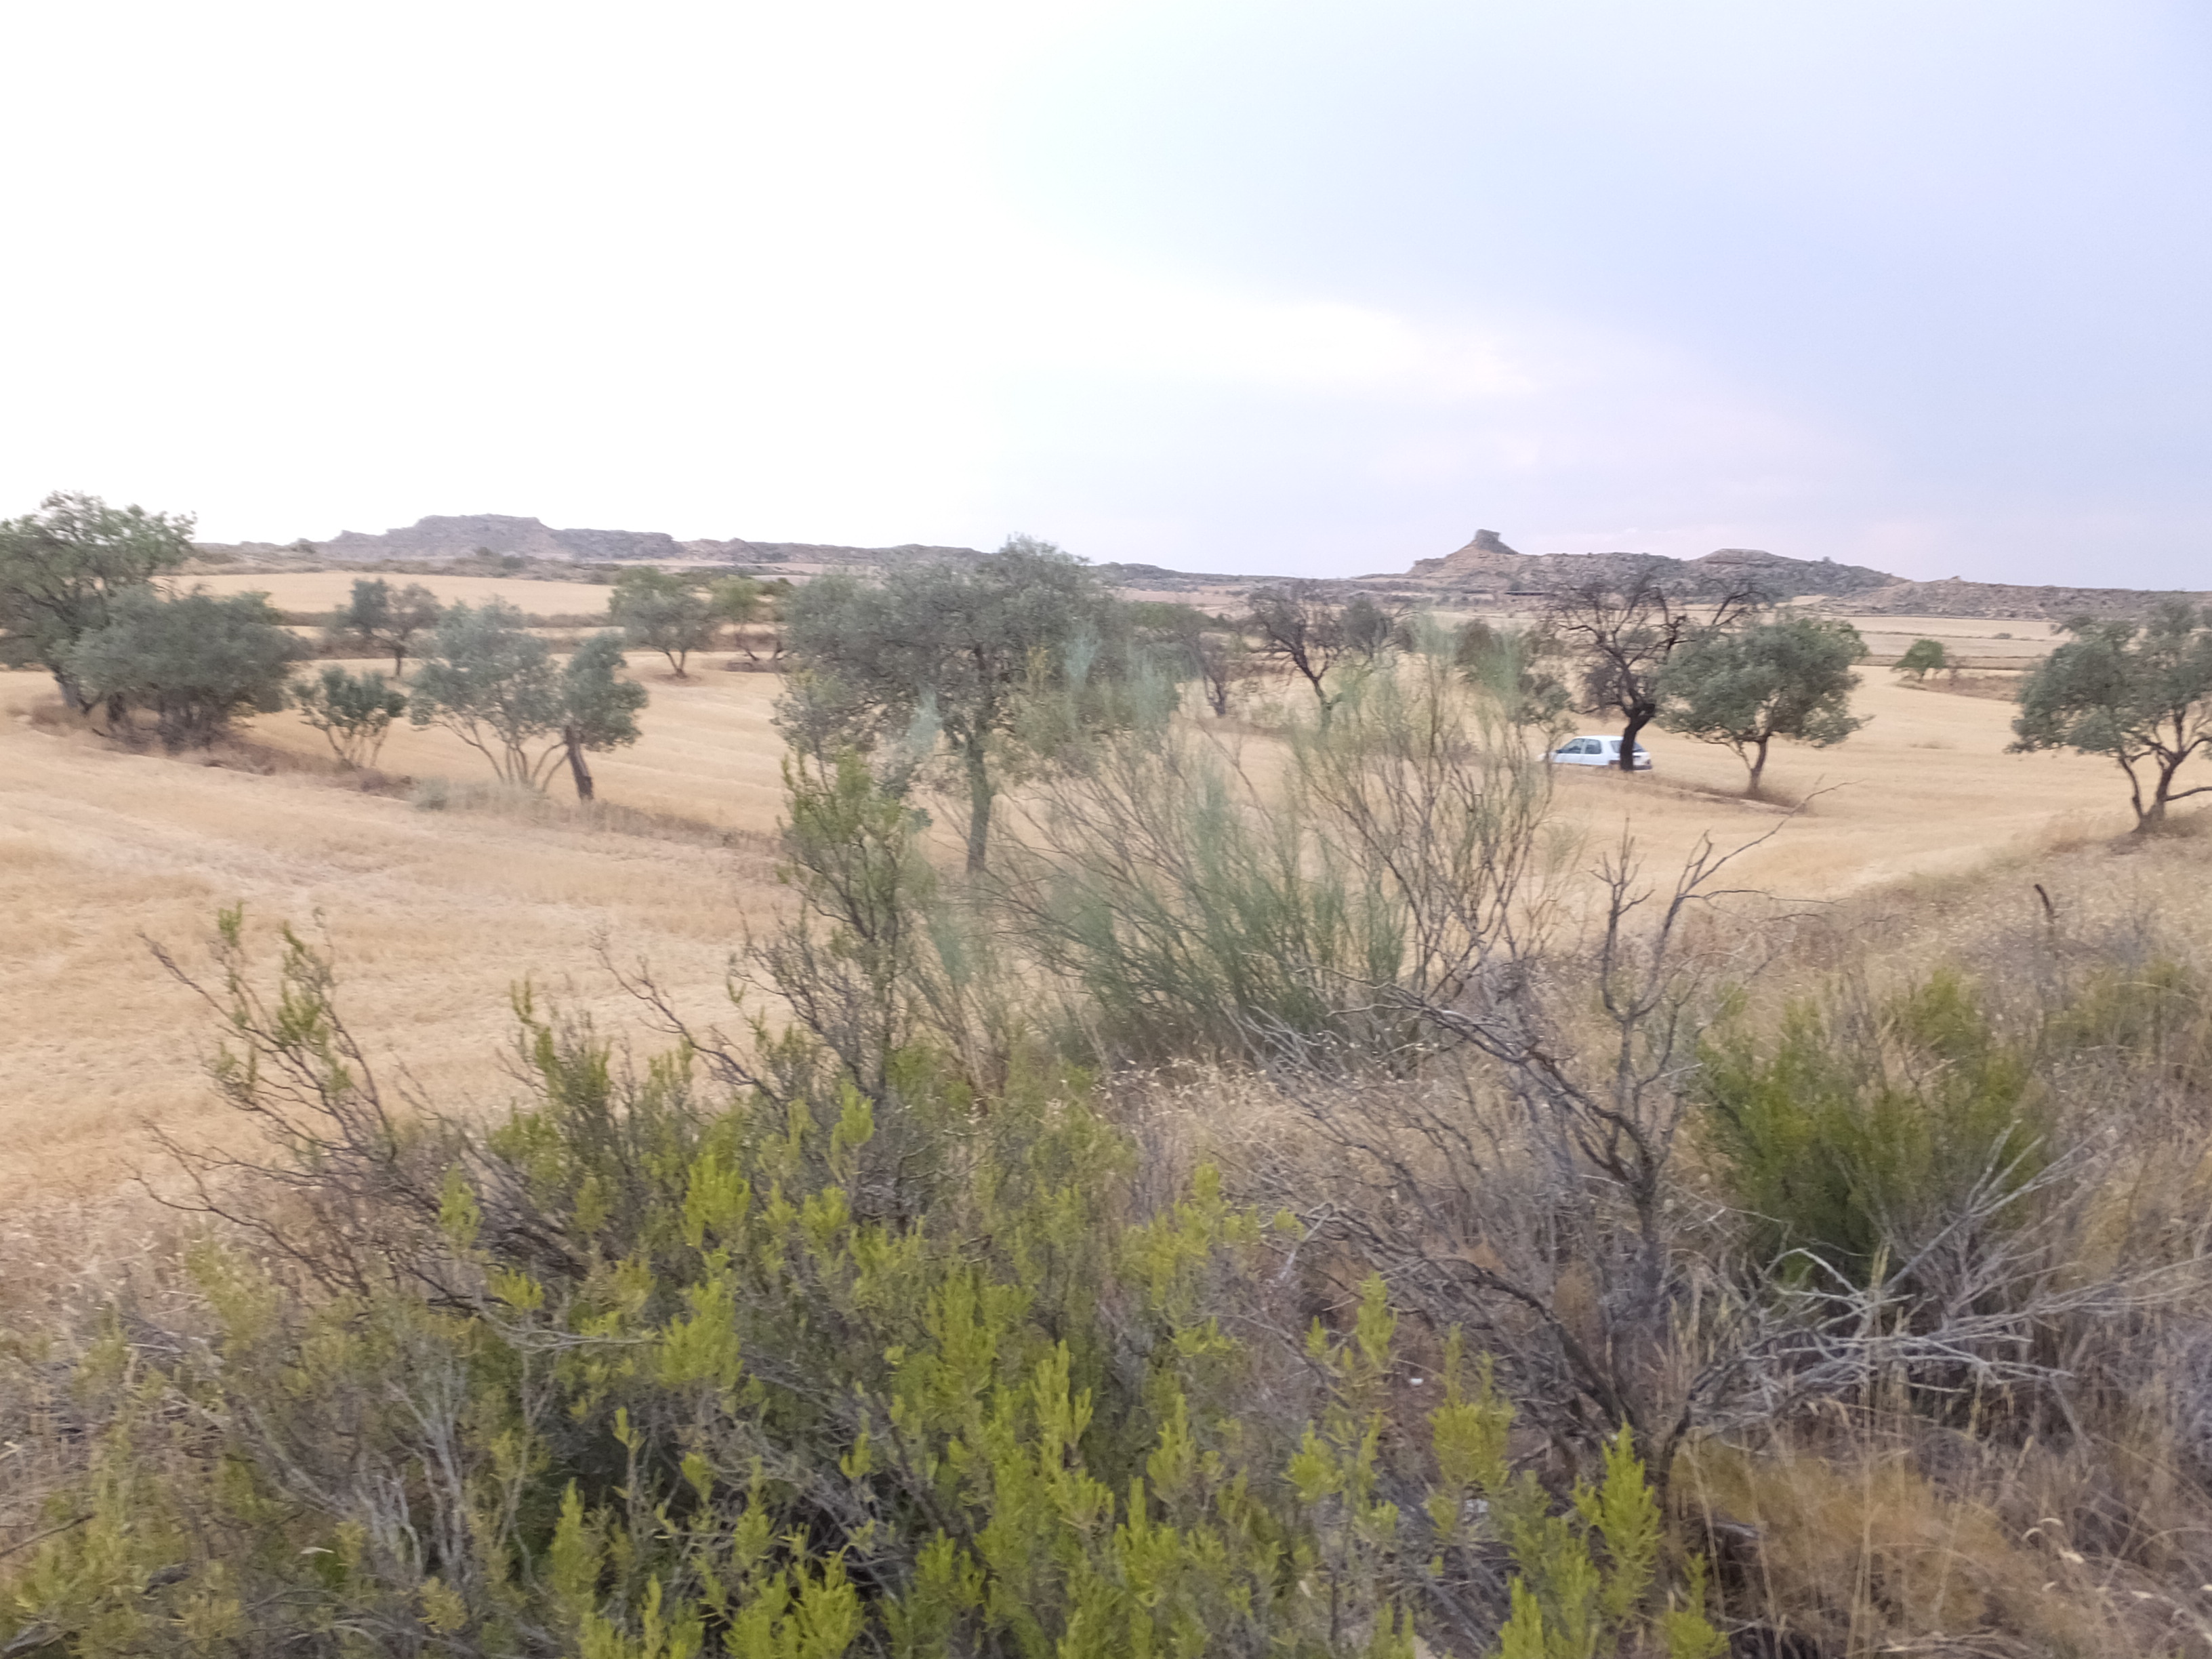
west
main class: Shrubland
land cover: Shrubland without tree cover
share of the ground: > 75 %
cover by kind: shrubs 50 %, herbaceous plants 50 %
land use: Semi-natural and natural areas not in use
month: July
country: ES
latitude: 41.1850
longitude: -0.0863
